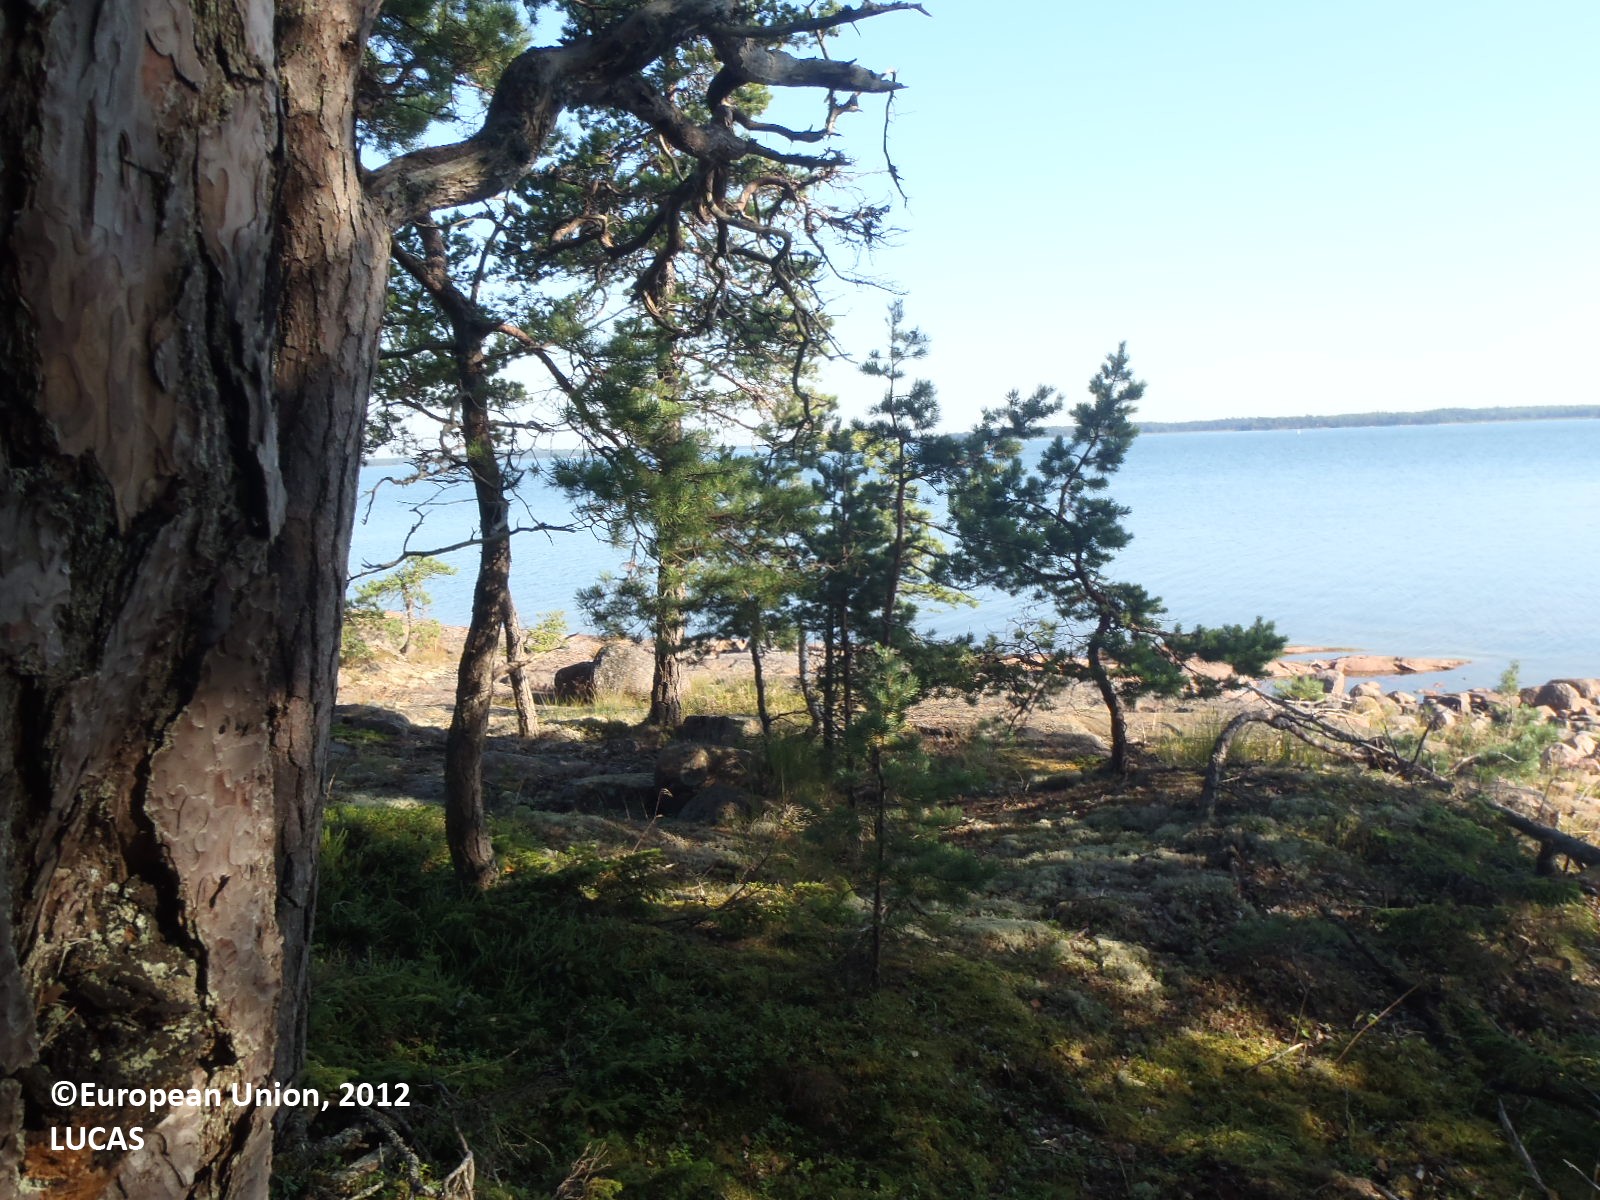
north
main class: Woodland
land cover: Pine dominated mixed woodland
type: hemiboreal forest and nemoral coniferous forest and mixed broadleaved-coniferous forest
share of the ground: 50 - 75 %
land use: Forestry
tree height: > 5 m
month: August
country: FI
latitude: 60.2222
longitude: 20.2804
